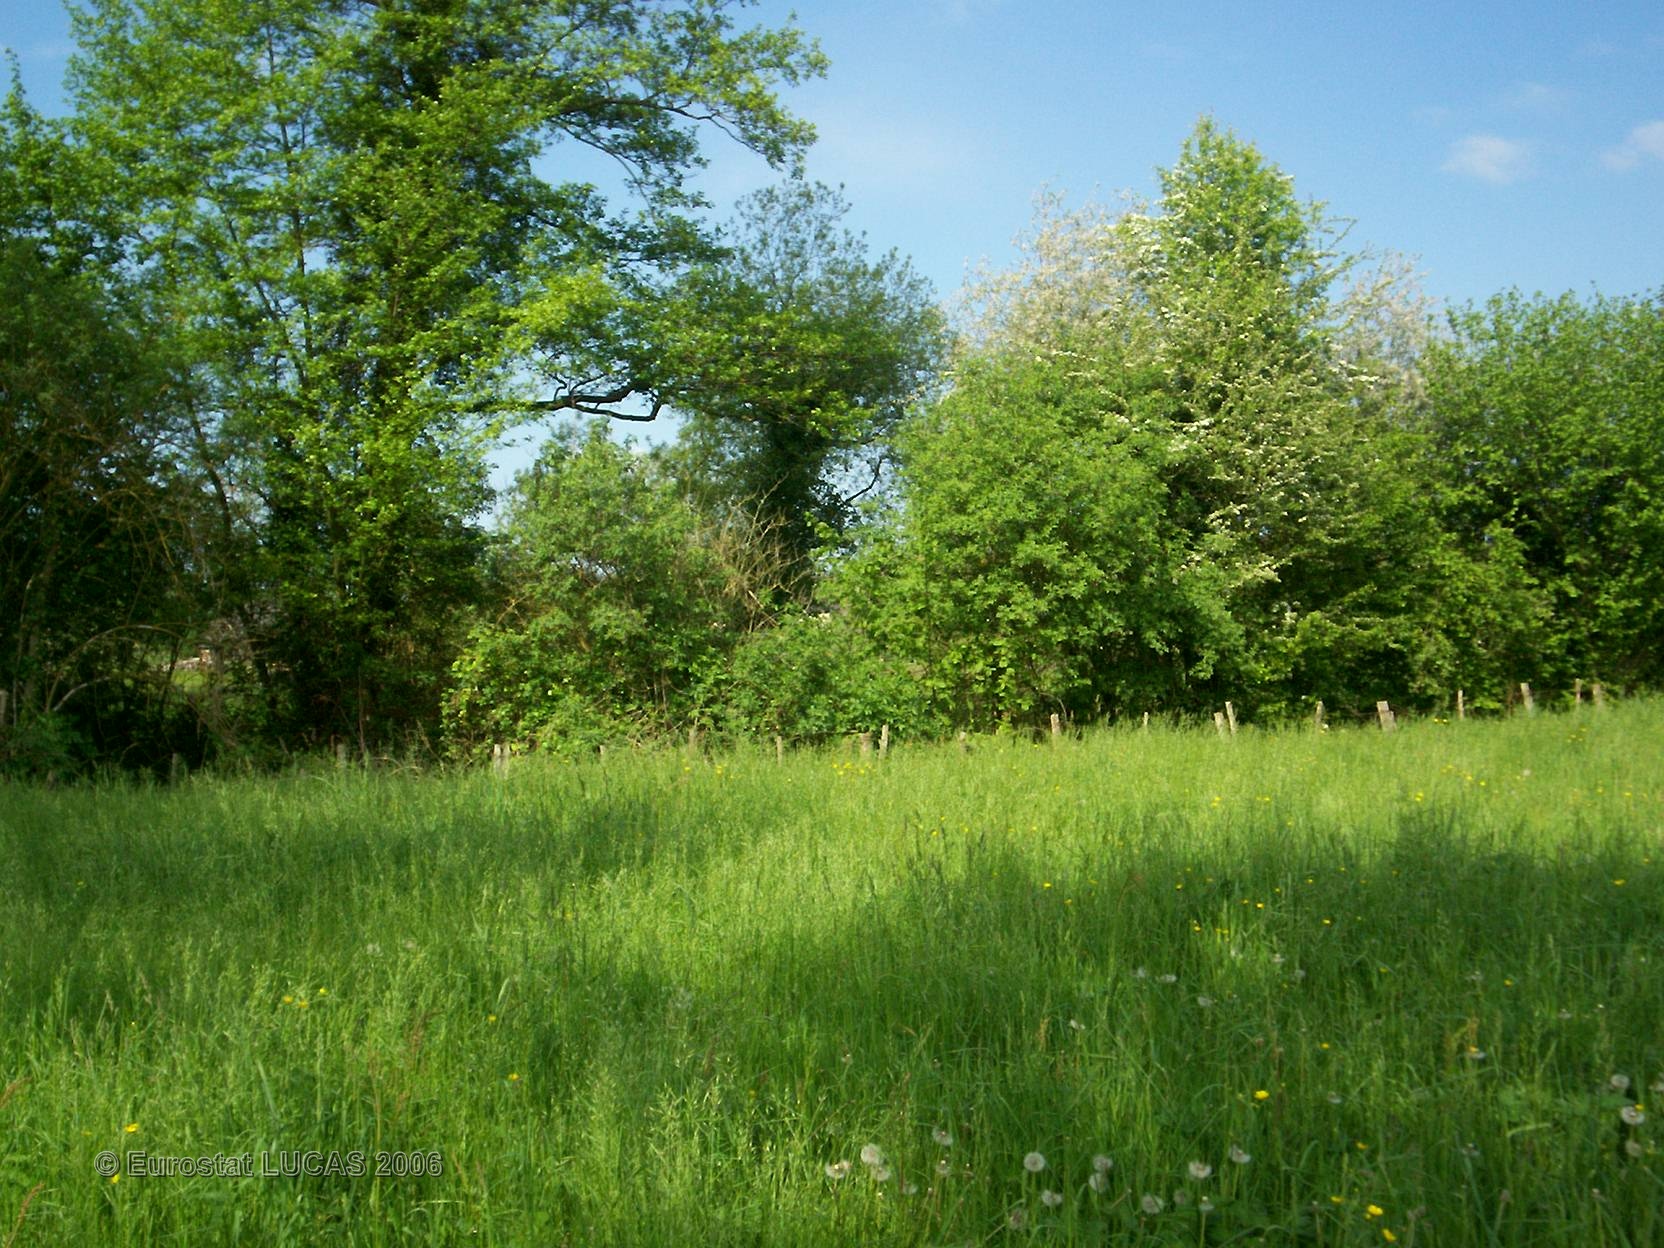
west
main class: Grassland
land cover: Grassland without tree/shrub cover
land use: Agriculture (excluding fallow land and kitchen gardens)
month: May
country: FR
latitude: 47.8184
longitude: 0.1577
